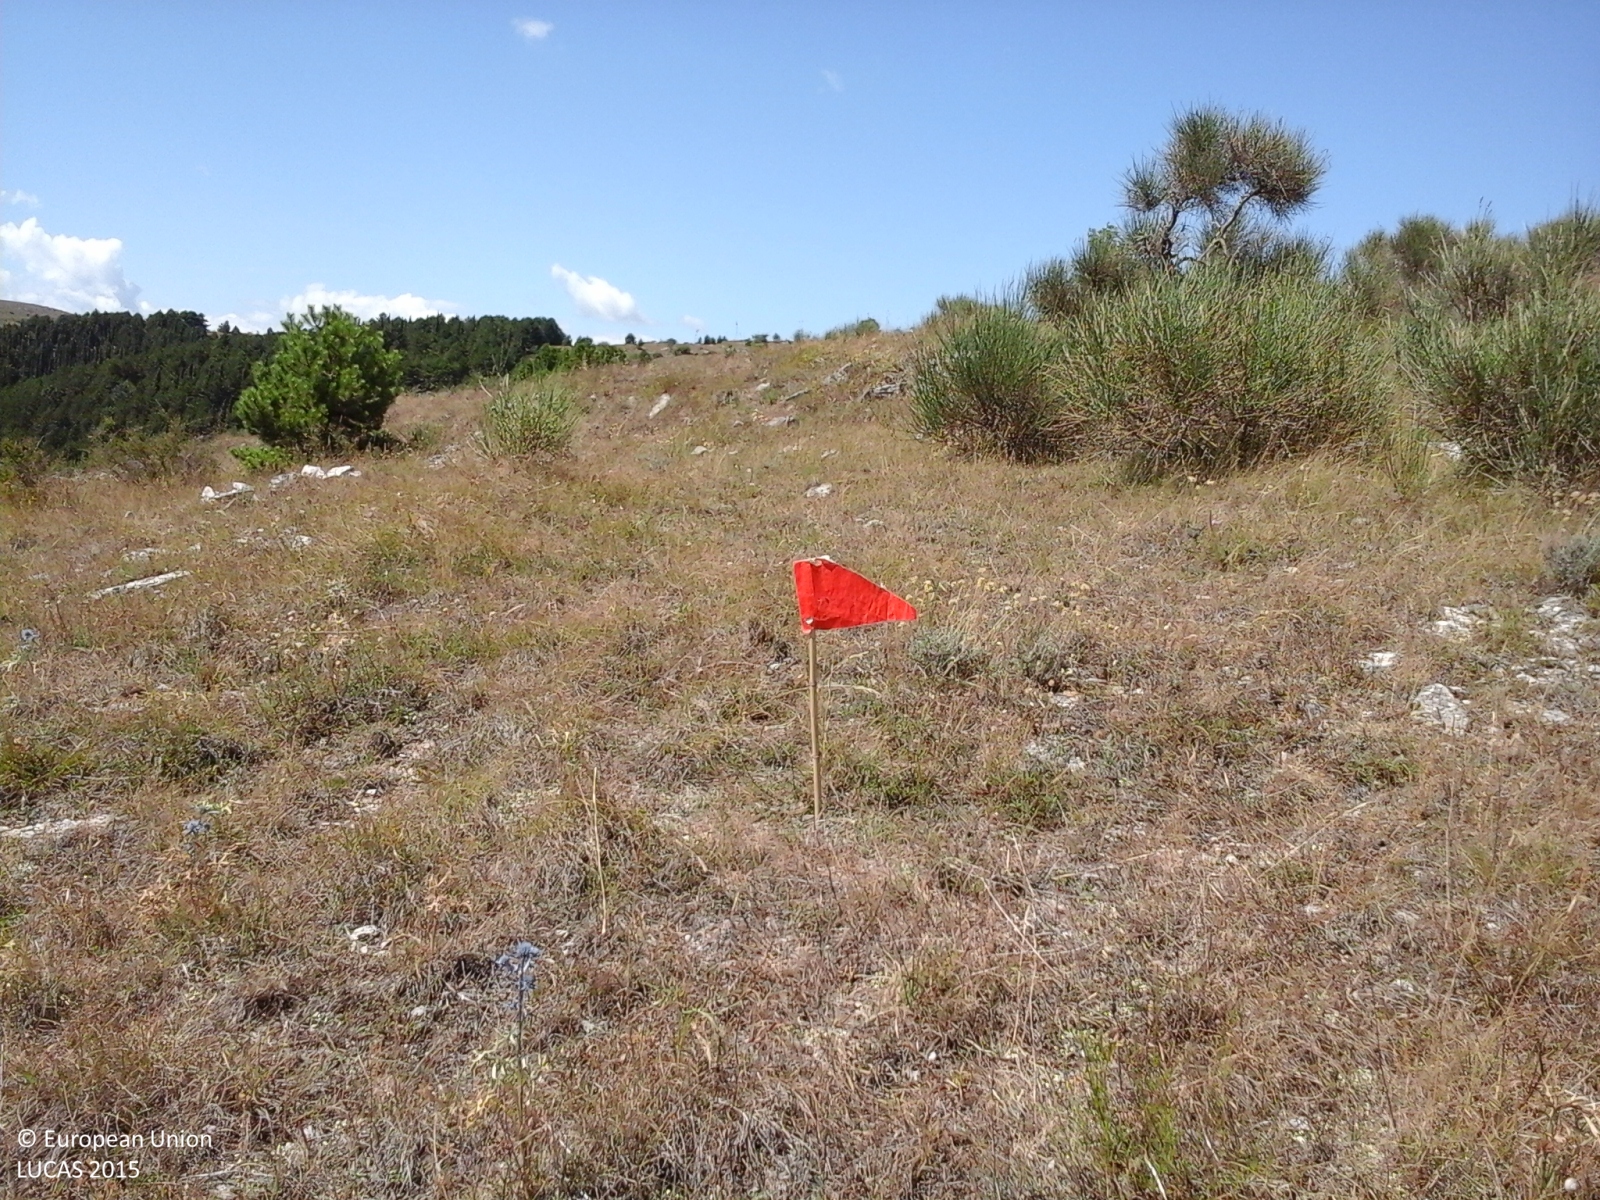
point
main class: Grassland
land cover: Grassland with sparse tree/shrub cover
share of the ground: > 75 %
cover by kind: herbaceous plants 90 %, broadleaved forest trees 5 %, shrubs 5 %
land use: Agriculture (excluding fallow land and kitchen gardens)
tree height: < 5 m
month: August
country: IT
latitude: 41.5640
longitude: 14.3852
